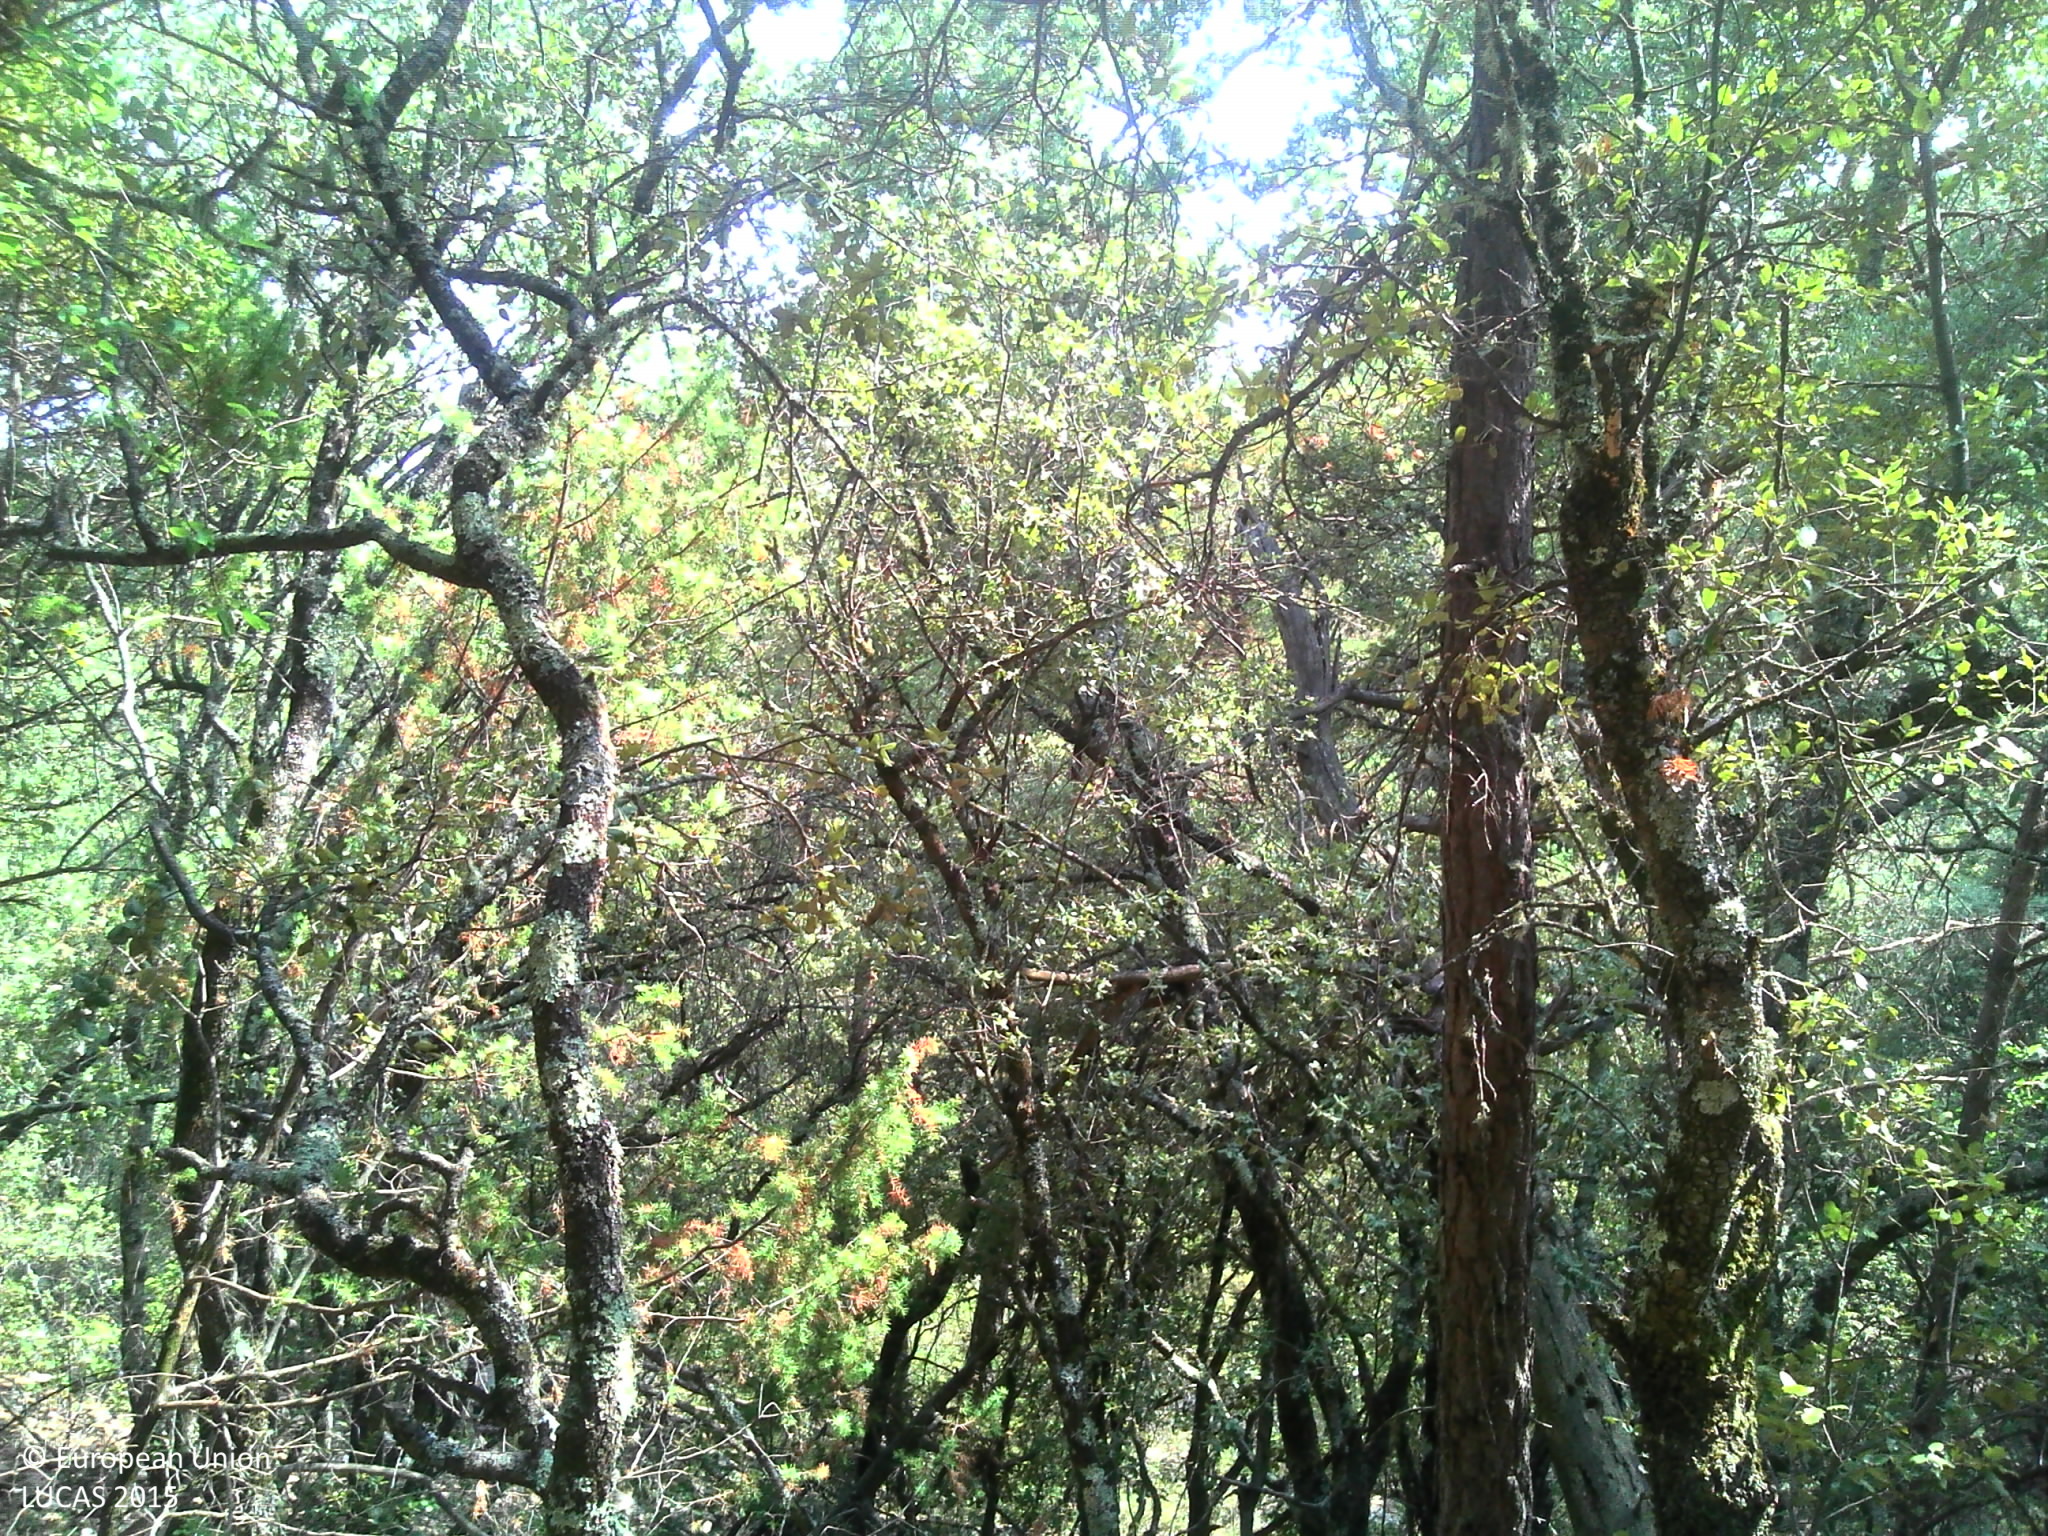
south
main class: Woodland
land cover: Broadleaved woodland
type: thermophilous deciduous forest
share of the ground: > 75 %
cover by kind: broadleaved forest trees 90 %, unconsolidated bare surface 10 %
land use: Semi-natural and natural areas not in use
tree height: > 5 m
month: August
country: FR
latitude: 43.6355
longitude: 6.3270
